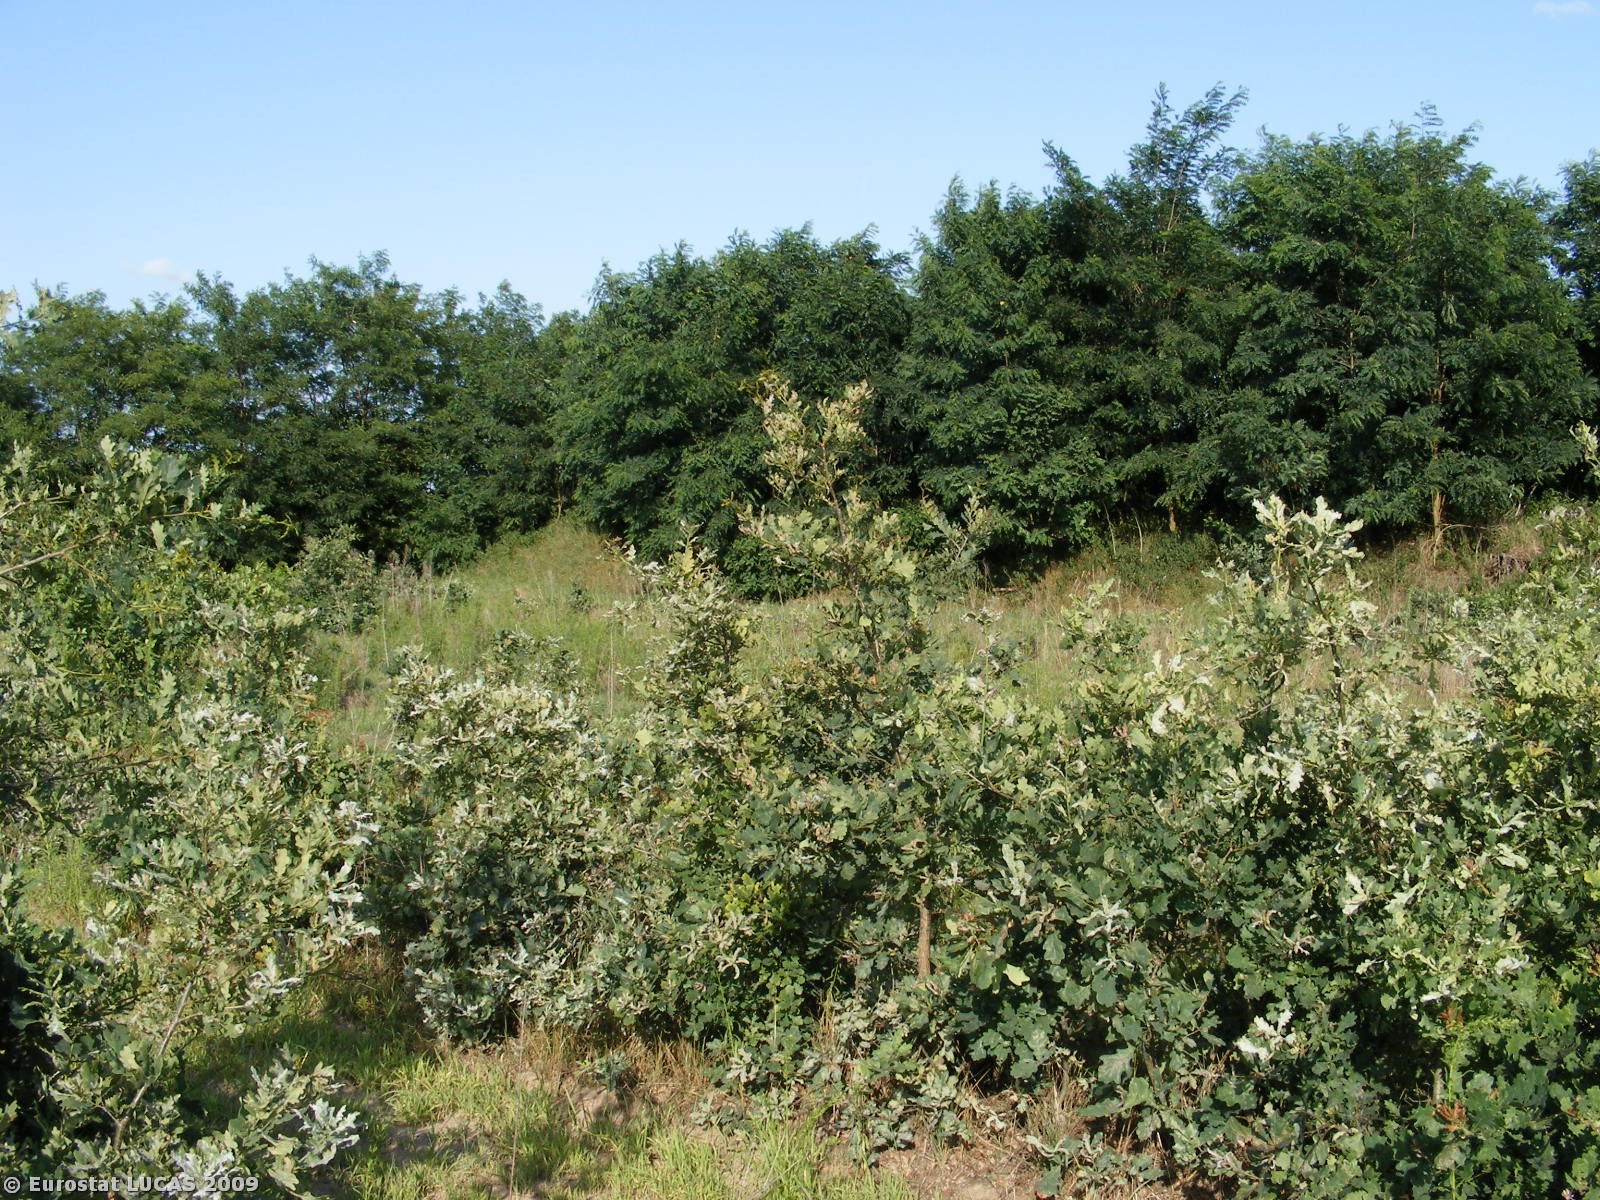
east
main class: Shrubland
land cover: Shrubland with sparse tree cover
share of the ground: 25 - 50 %
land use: Forestry
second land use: Nature reserves
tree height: < 5 m
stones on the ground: < 10 %
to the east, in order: Shrubland with sparse tree cover; Abandoned hedges; Shrubland with sparse tree cover; Abandoned hedges; Tracks; Abandoned hedges; Broadleaved woodland
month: July
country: HU
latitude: 47.4615
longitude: 21.7864
